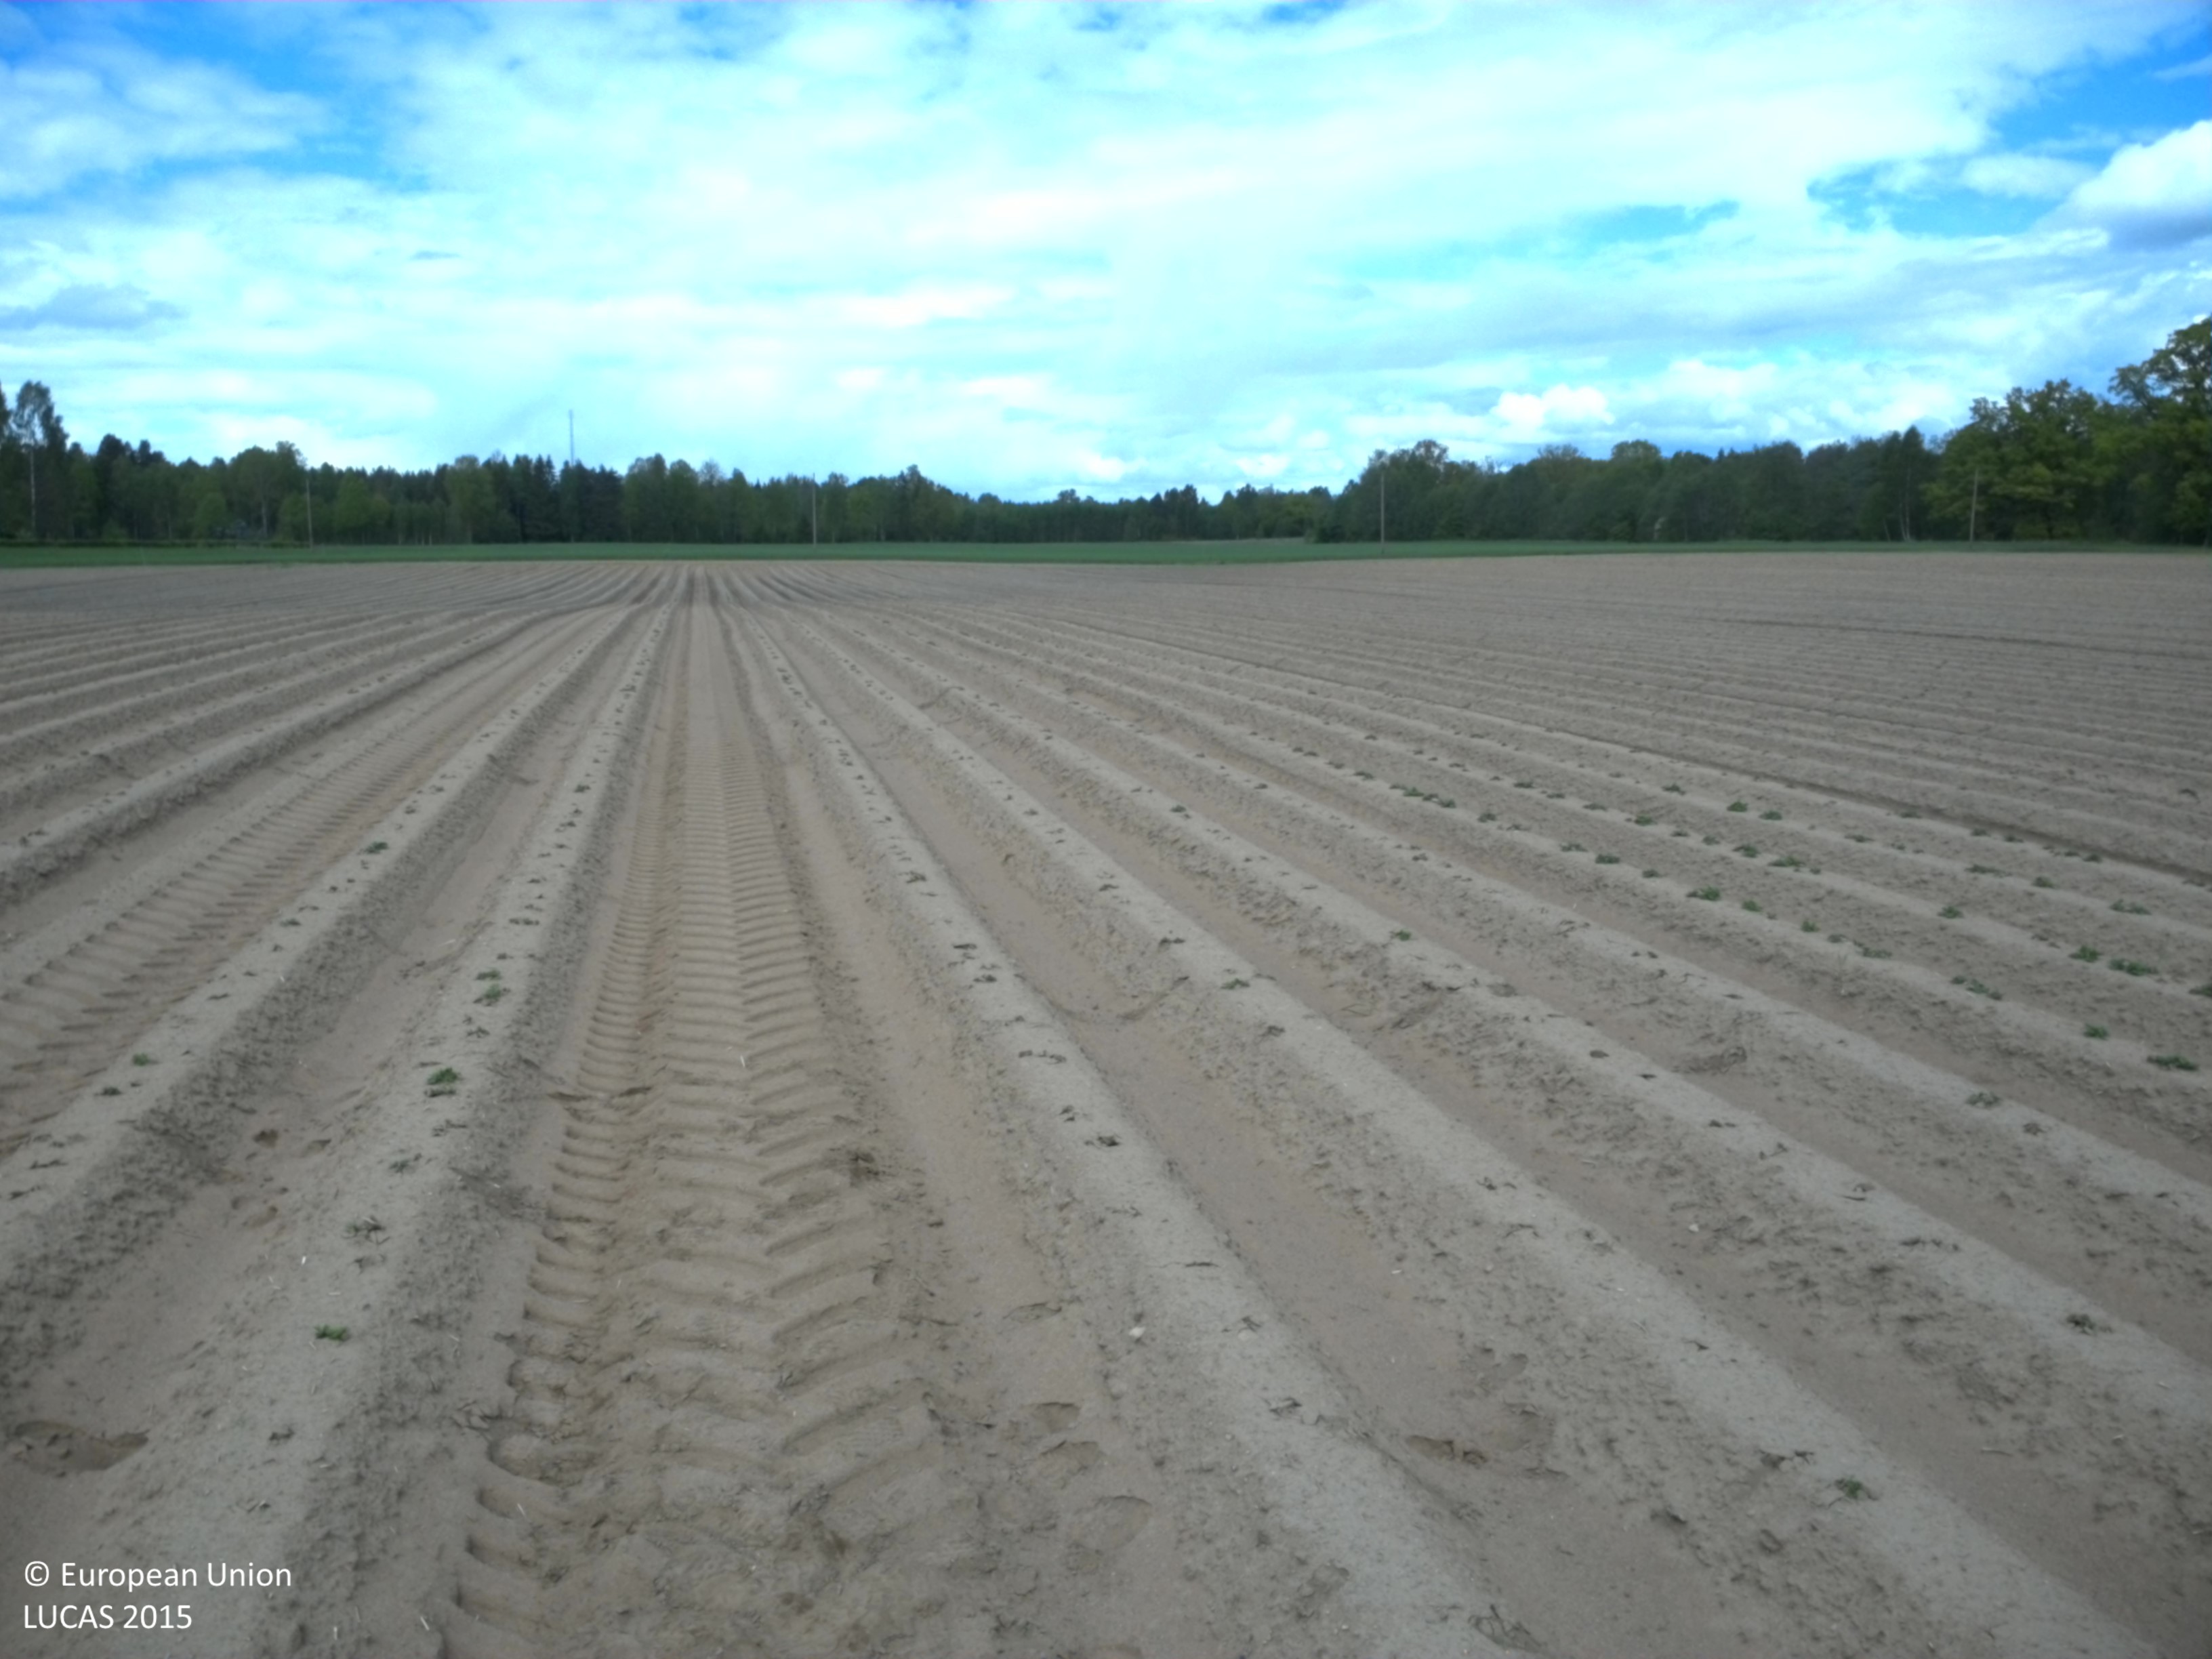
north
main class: Cropland
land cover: Potatoes
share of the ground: < 10 %
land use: Agriculture (excluding fallow land and kitchen gardens)
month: May
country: SE
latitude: 57.3714
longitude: 15.8345
